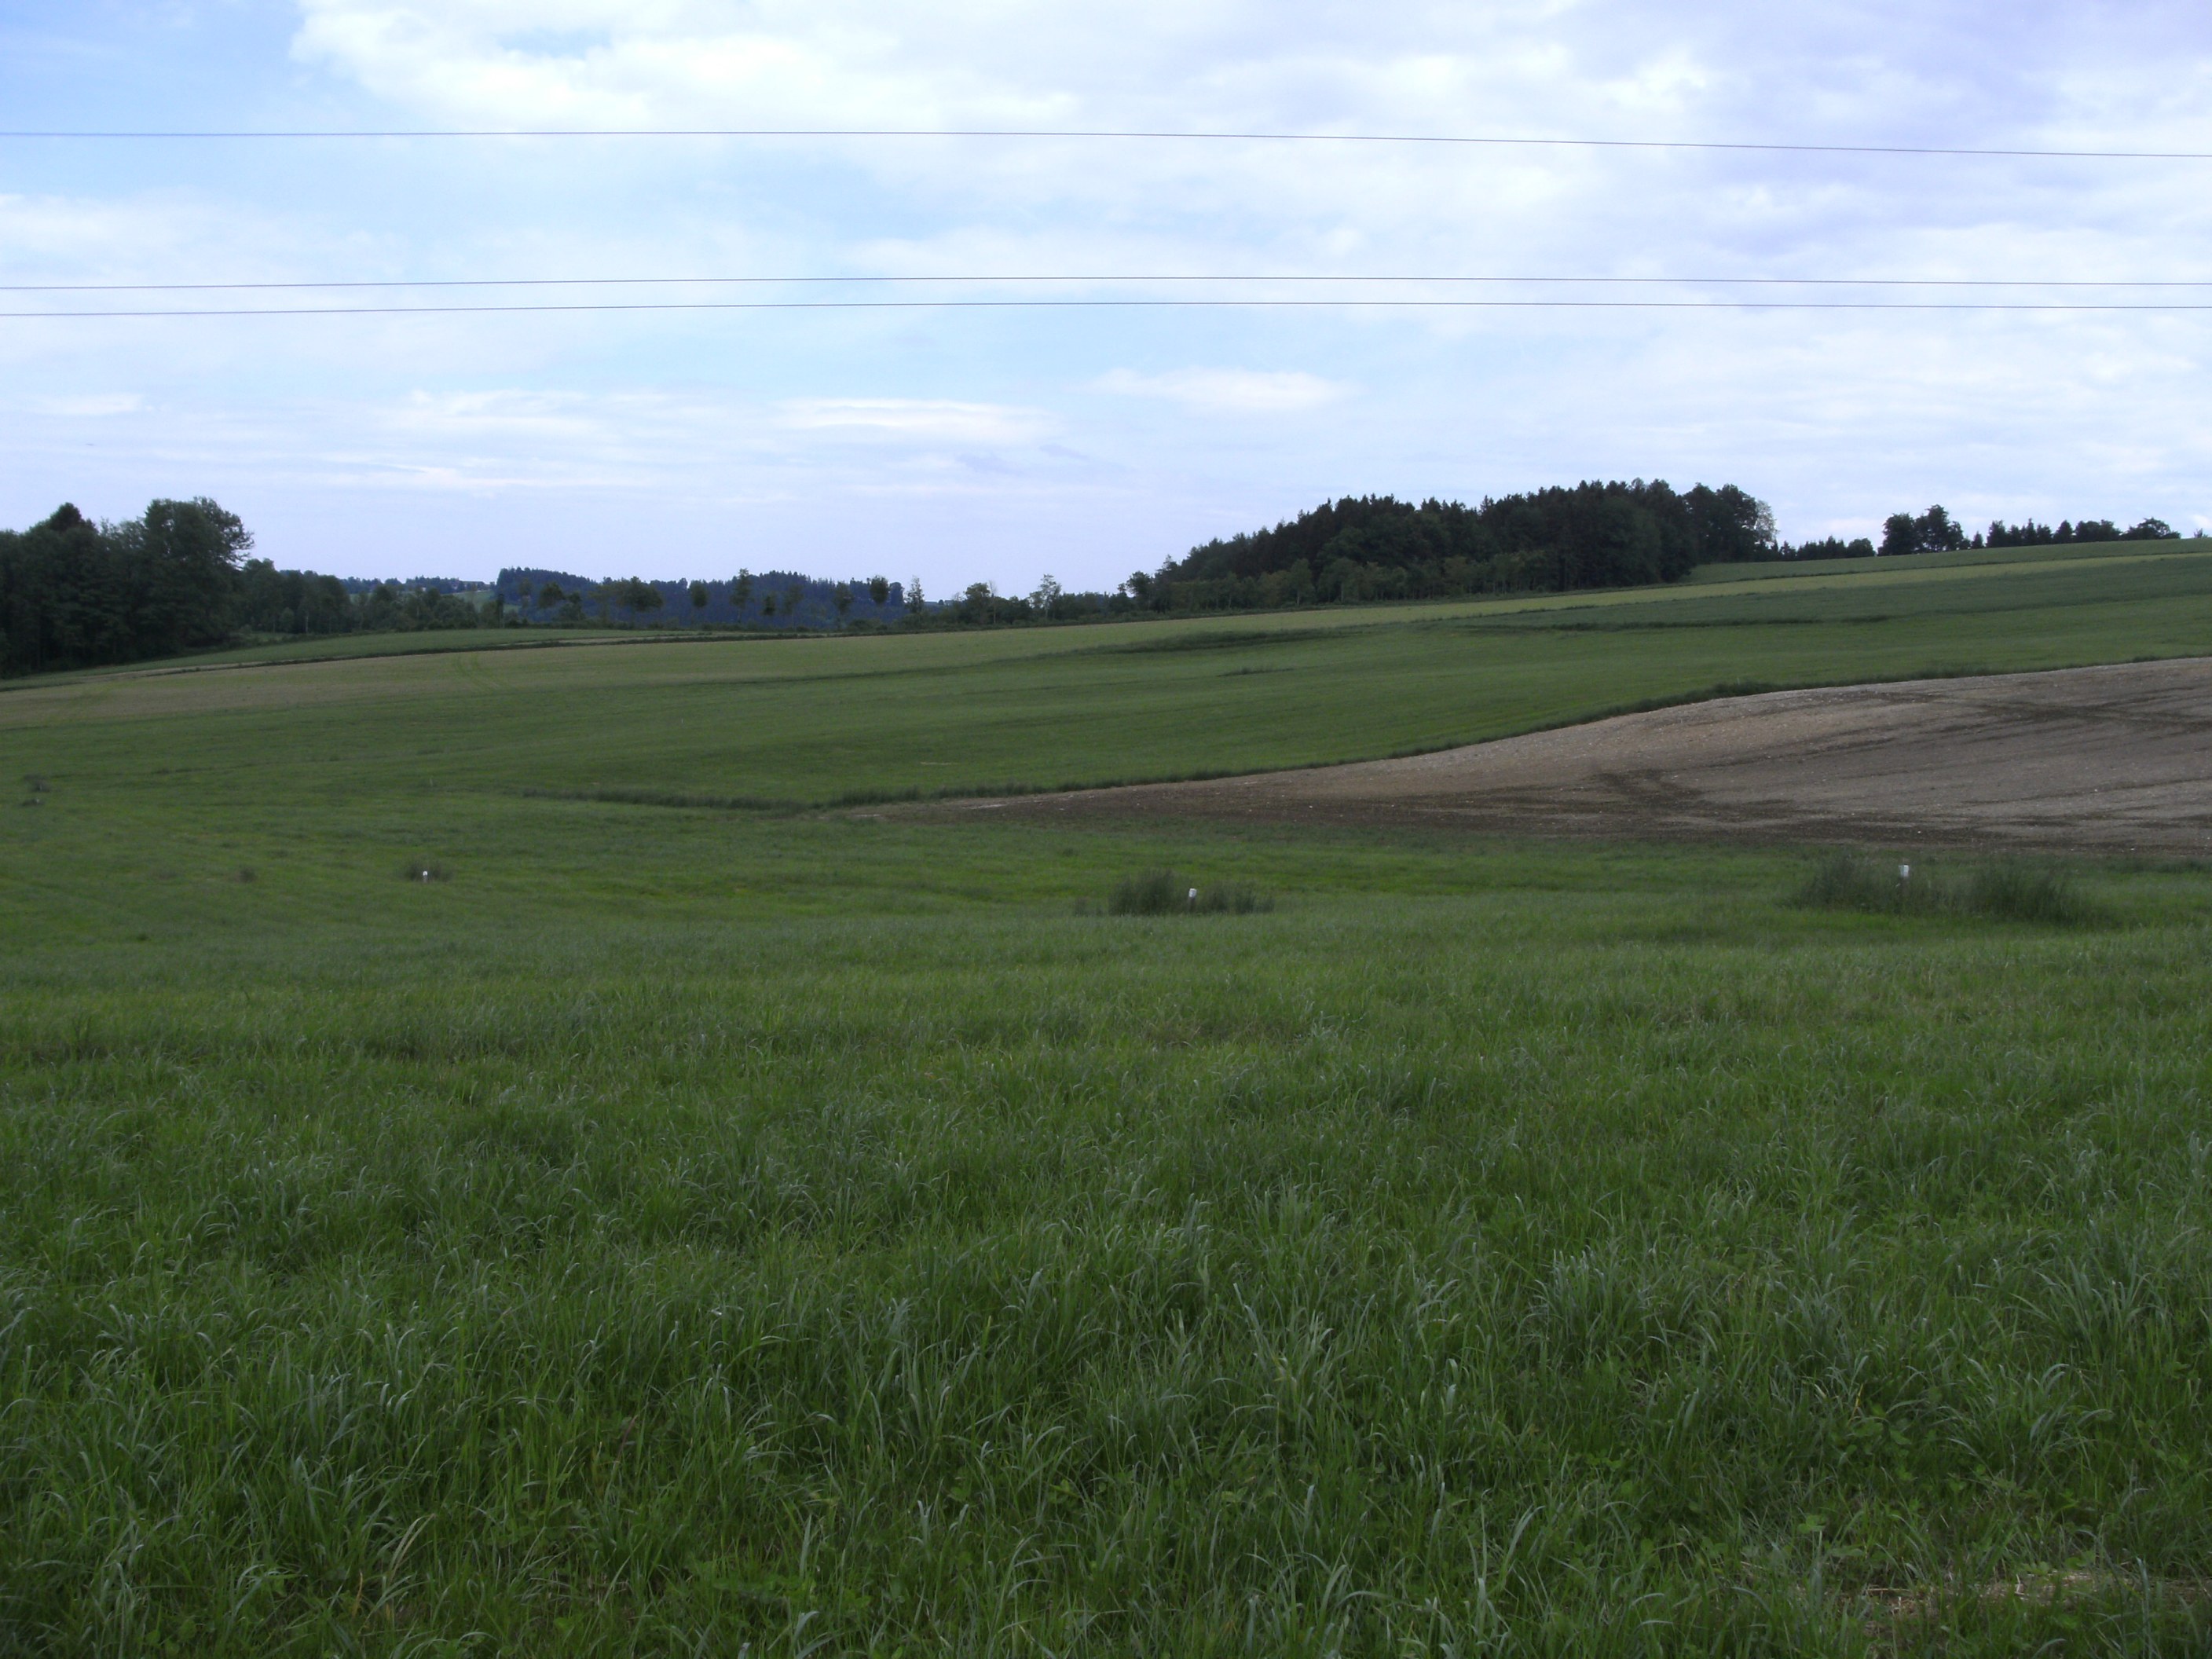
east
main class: Grassland
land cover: Grassland without tree/shrub cover
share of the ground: > 75 %
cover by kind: herbaceous plants 100 %
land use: Agriculture (excluding fallow land and kitchen gardens)
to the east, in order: Grassland without tree/shrub cover; Electric lines; Grassland without tree/shrub cover; Maize; Grass margins; Grassland without tree/shrub cover
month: May
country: AT
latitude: 48.0428
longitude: 13.4732
